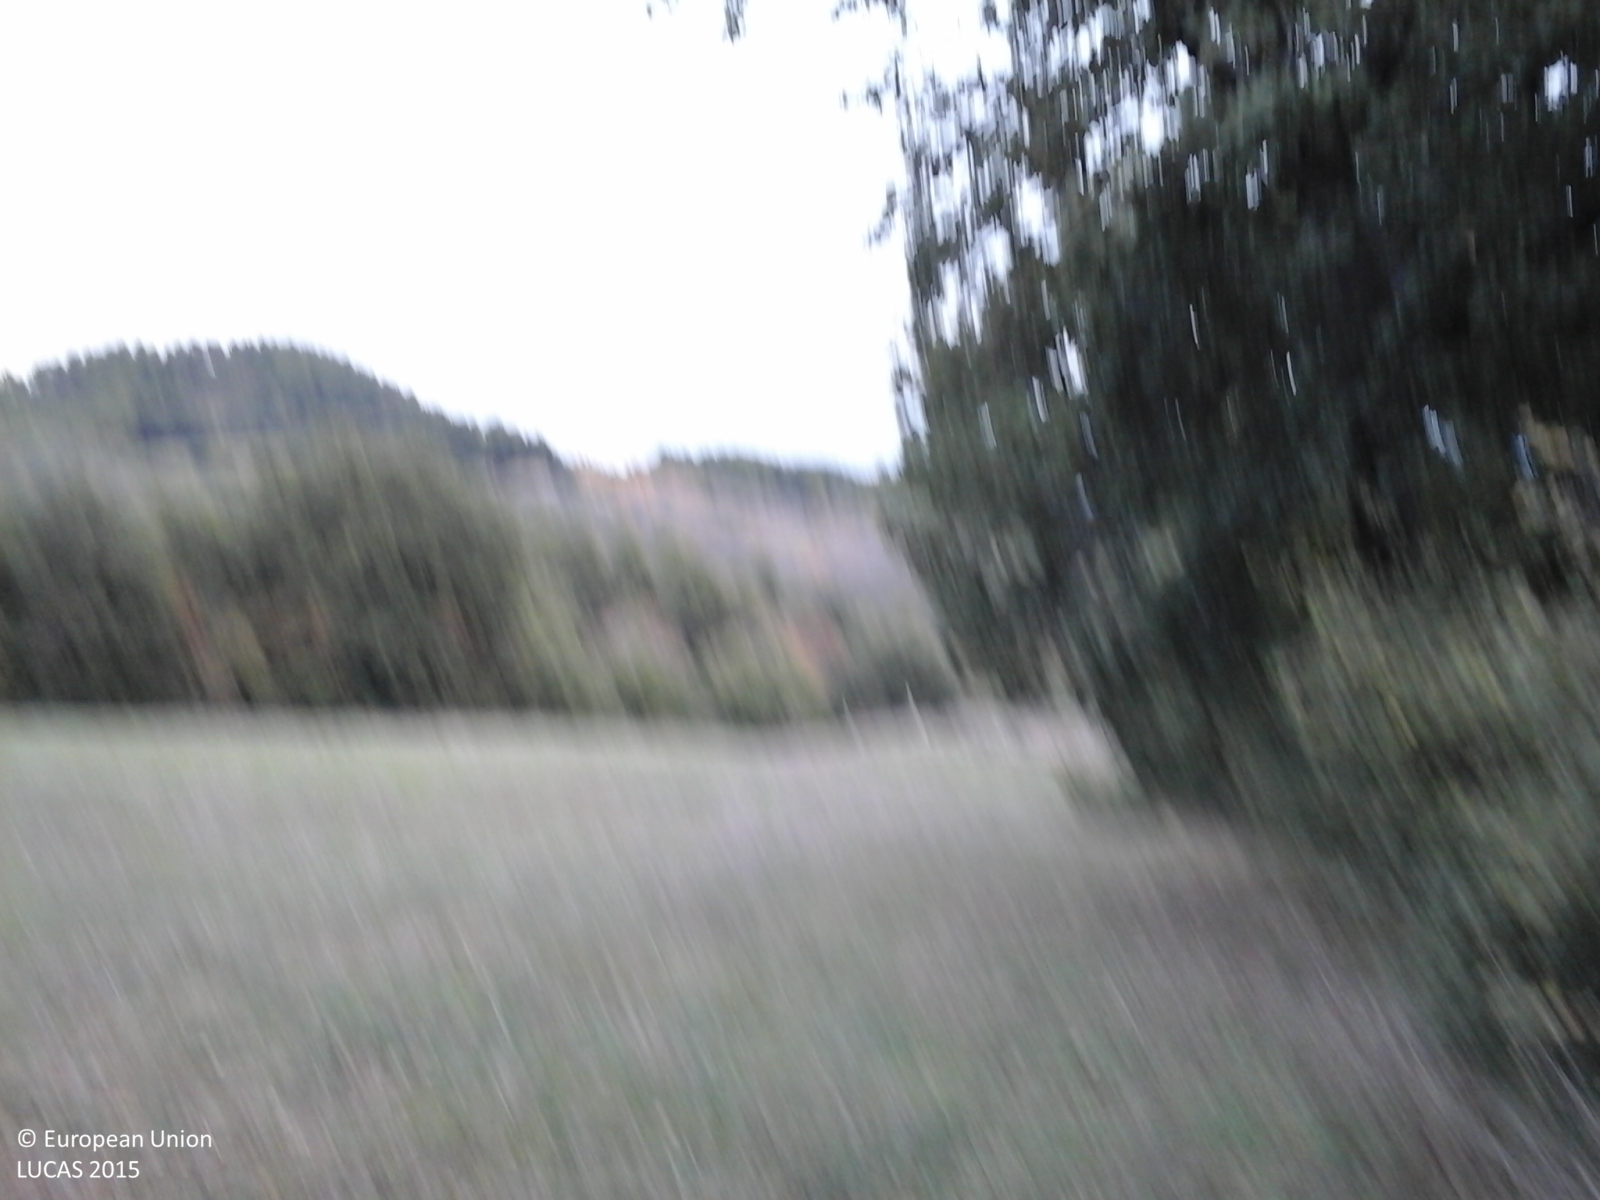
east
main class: Woodland
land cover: Broadleaved woodland
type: thermophilous deciduous forest
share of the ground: 50 - 75 %
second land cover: Grassland without tree/shrub cover
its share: 50 - 75 %
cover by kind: broadleaved forest trees 60 %, herbaceous plants 35 %, shrubs 5 %
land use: Forestry
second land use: Agriculture (excluding fallow land and kitchen gardens)
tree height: > 5 m
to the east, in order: Broadleaved woodland; Grassland without tree/shrub cover; Arable land (only in case pi)
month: October
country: IT
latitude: 42.7647
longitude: 12.6192
